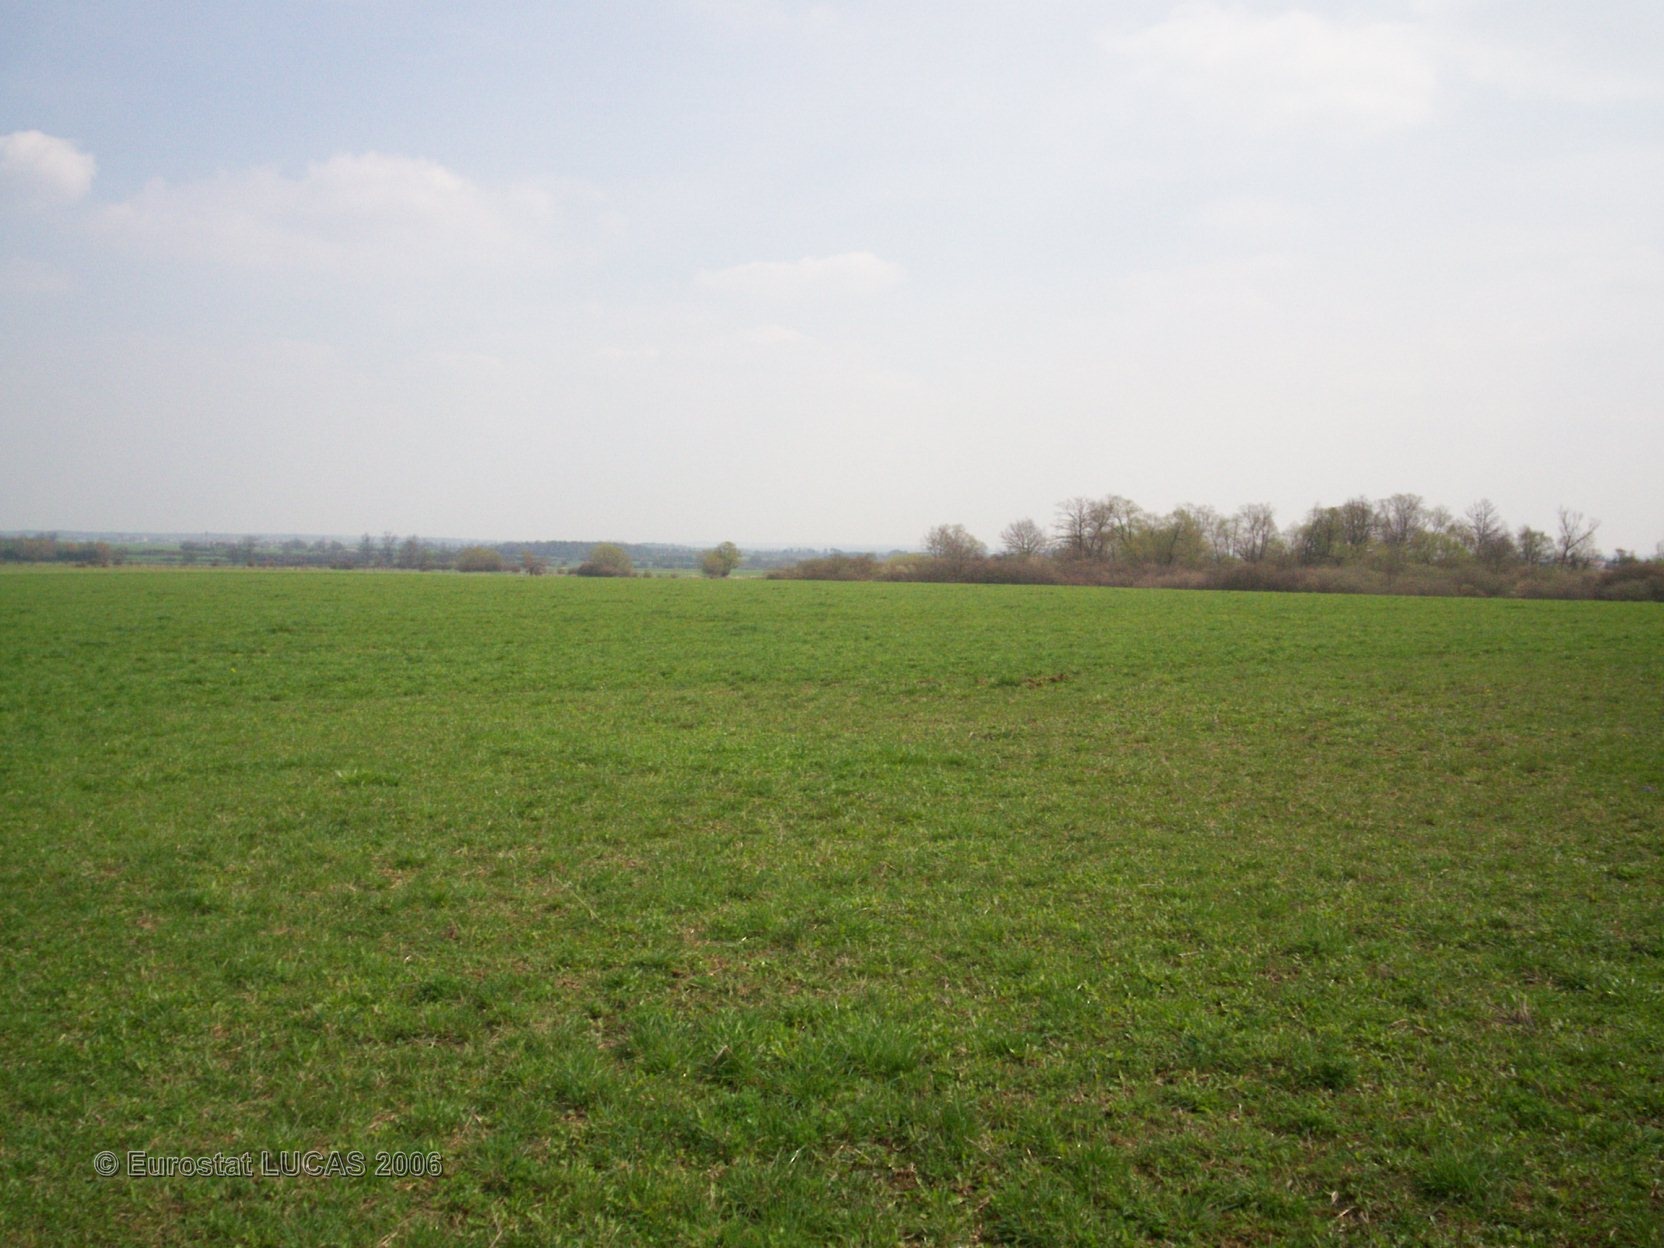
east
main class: Grassland
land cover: Grassland without tree/shrub cover
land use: Agriculture (excluding fallow land and kitchen gardens)
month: April
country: FR
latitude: 48.7421
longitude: 5.9065
